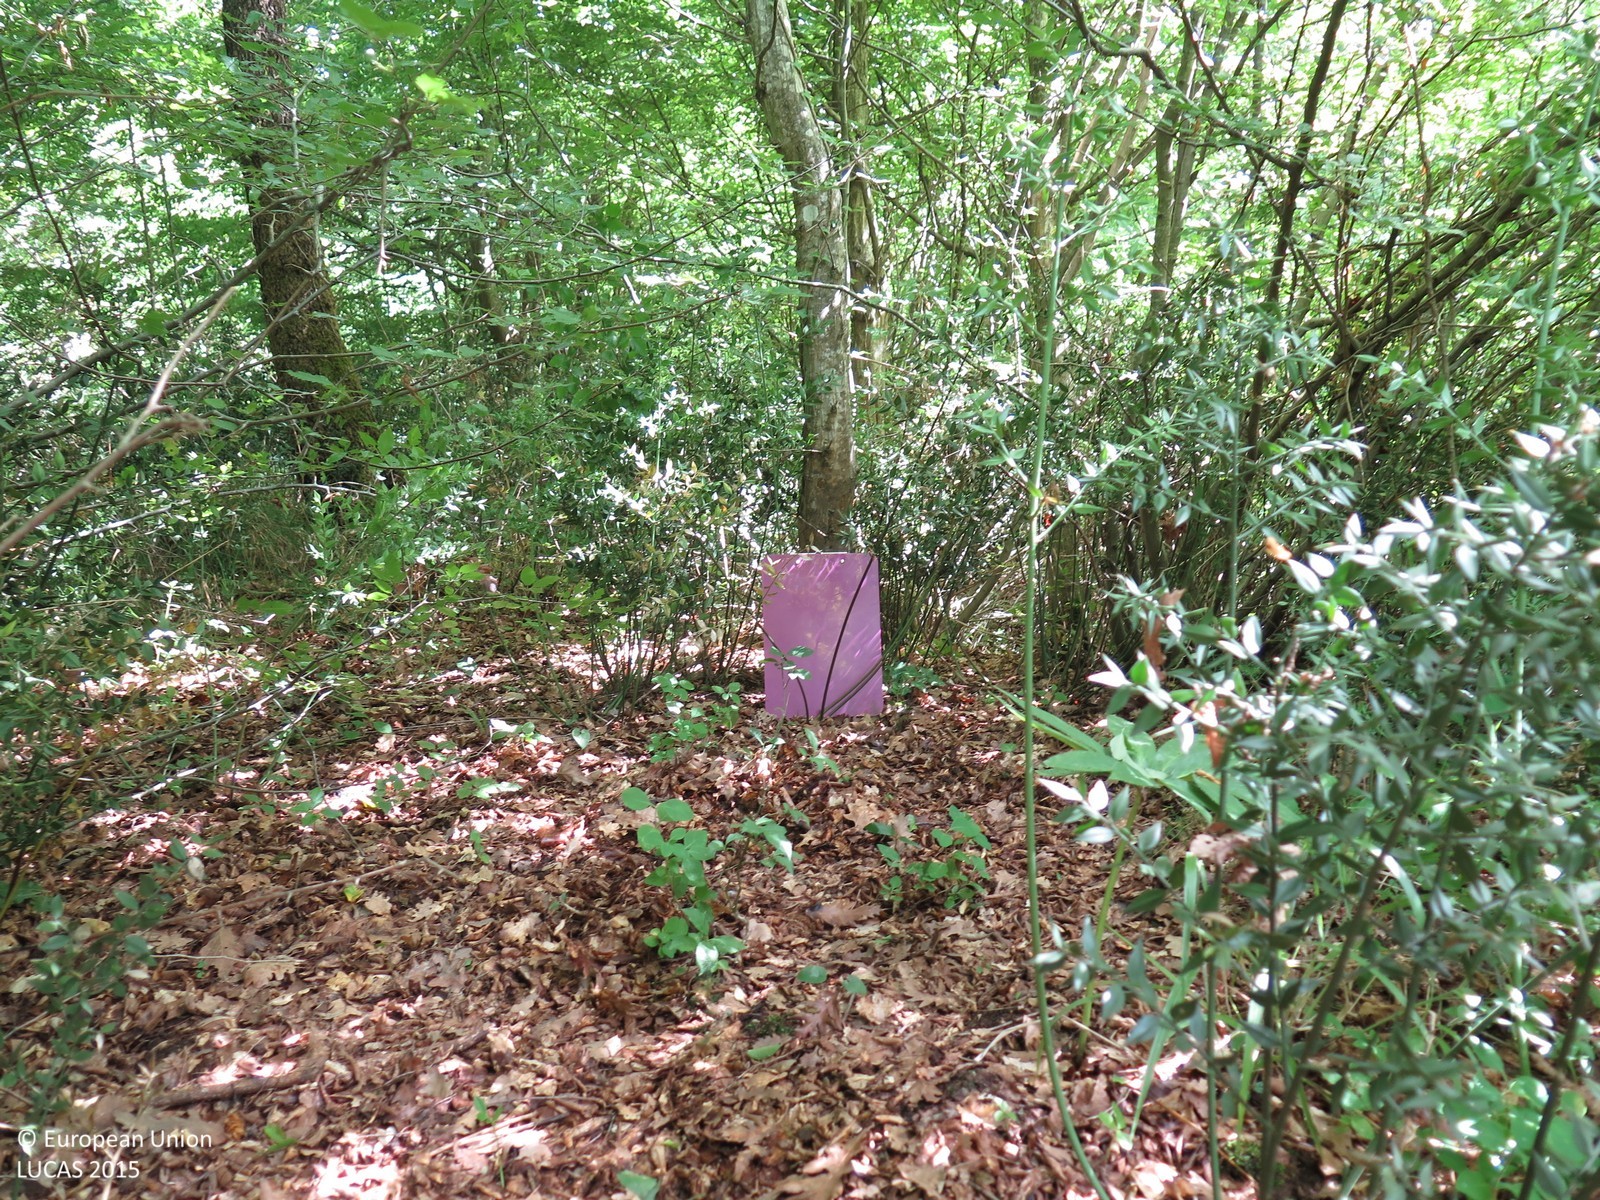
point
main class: Woodland
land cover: Broadleaved woodland
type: beech forest
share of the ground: > 75 %
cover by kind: broadleaved forest trees 90 %, shrubs 5 %, herbaceous plants 5 %
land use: Semi-natural and natural areas not in use
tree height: > 5 m
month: June
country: HR
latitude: 45.2608
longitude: 13.6524
